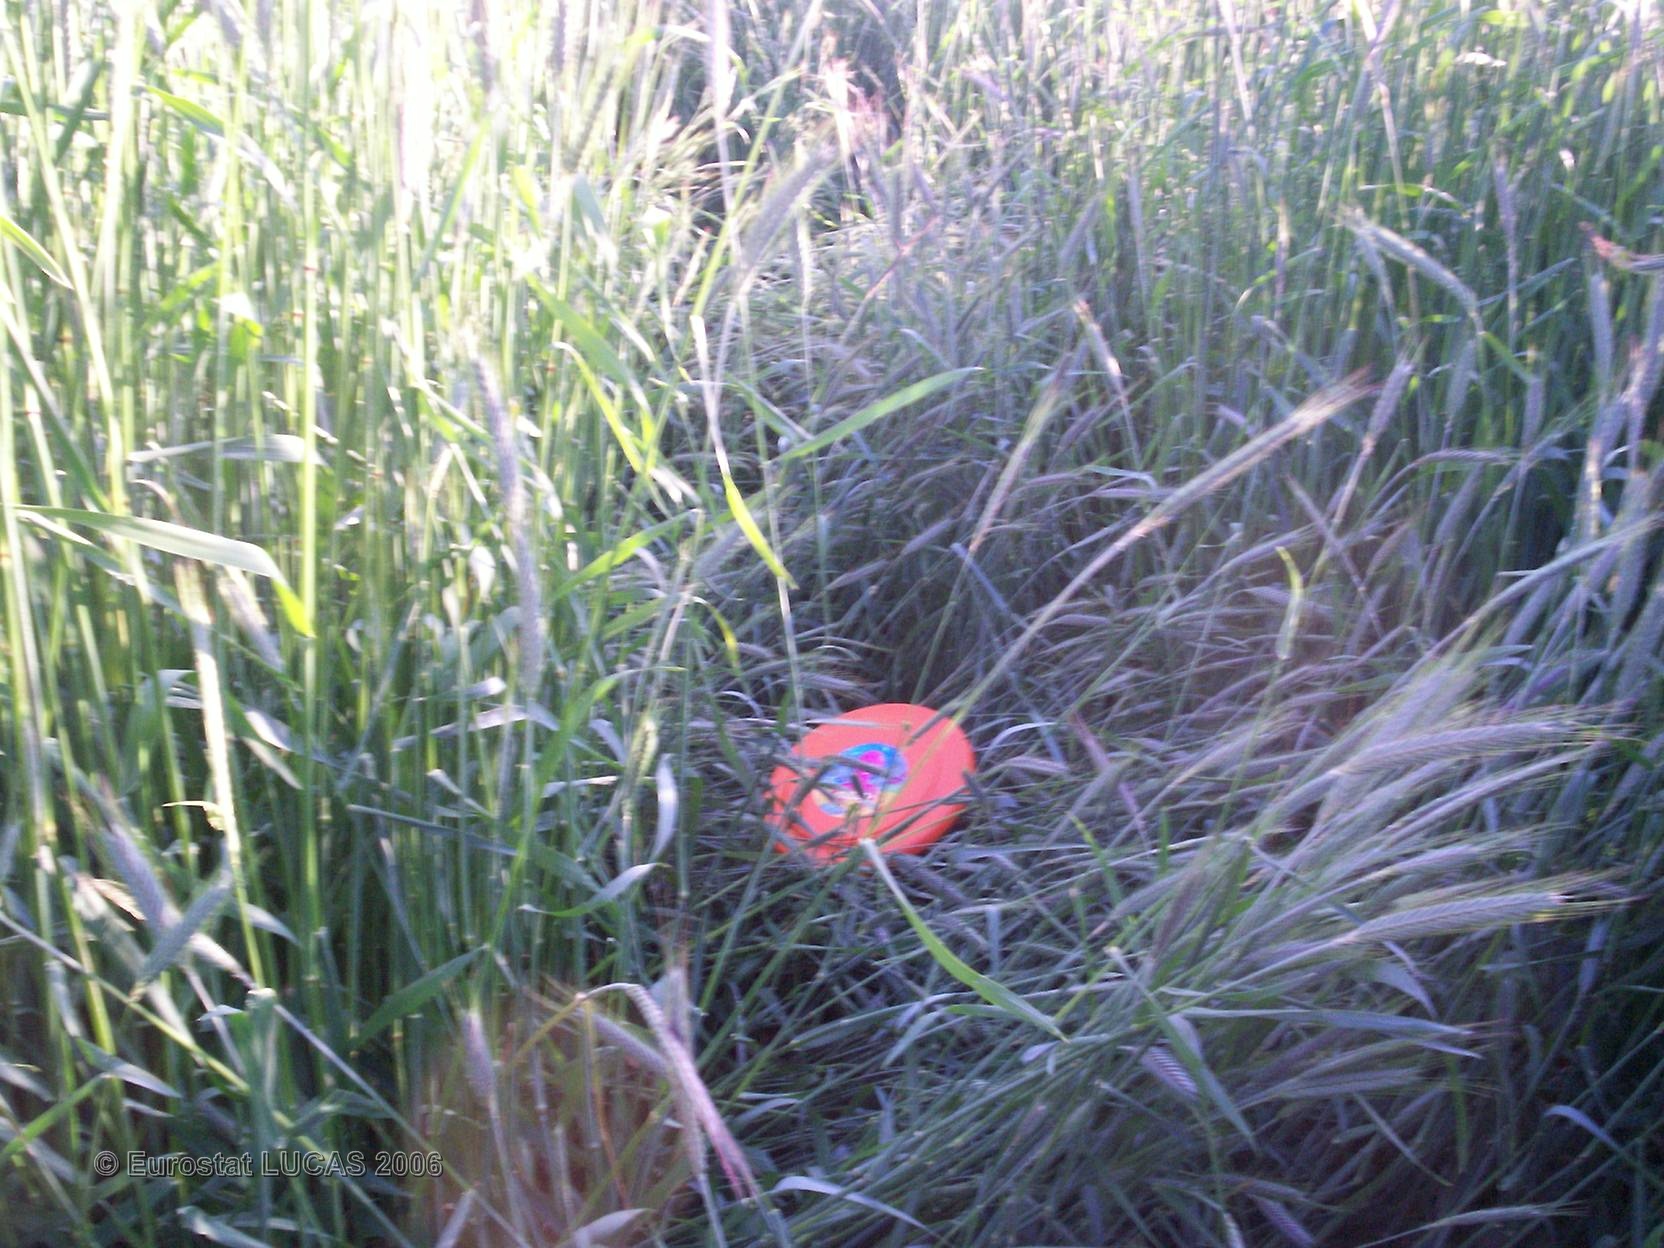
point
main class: Cropland
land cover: Common wheat
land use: Agriculture (excluding fallow land and kitchen gardens)
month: May
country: FR
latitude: 44.6623
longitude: 3.3578
